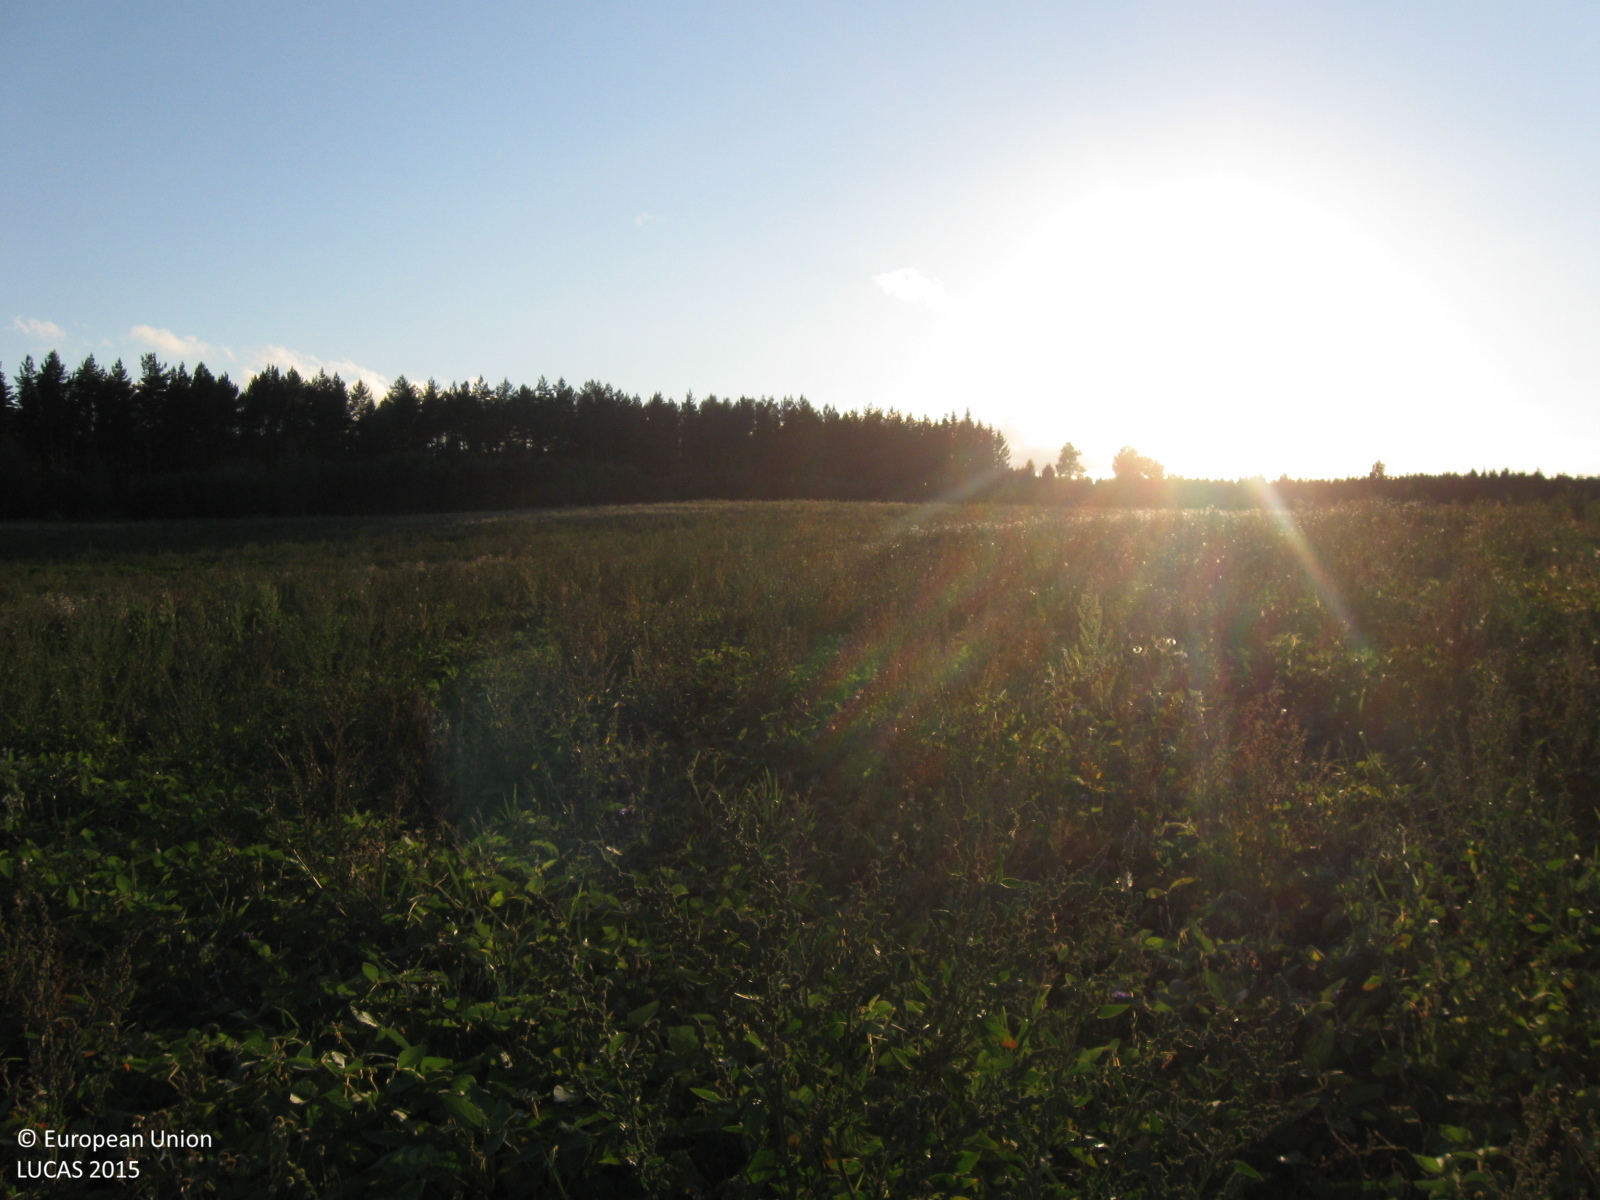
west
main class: Cropland
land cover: Soya
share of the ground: > 75 %
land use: Agriculture (excluding fallow land and kitchen gardens)
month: August
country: LT
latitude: 55.2952
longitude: 23.2569
